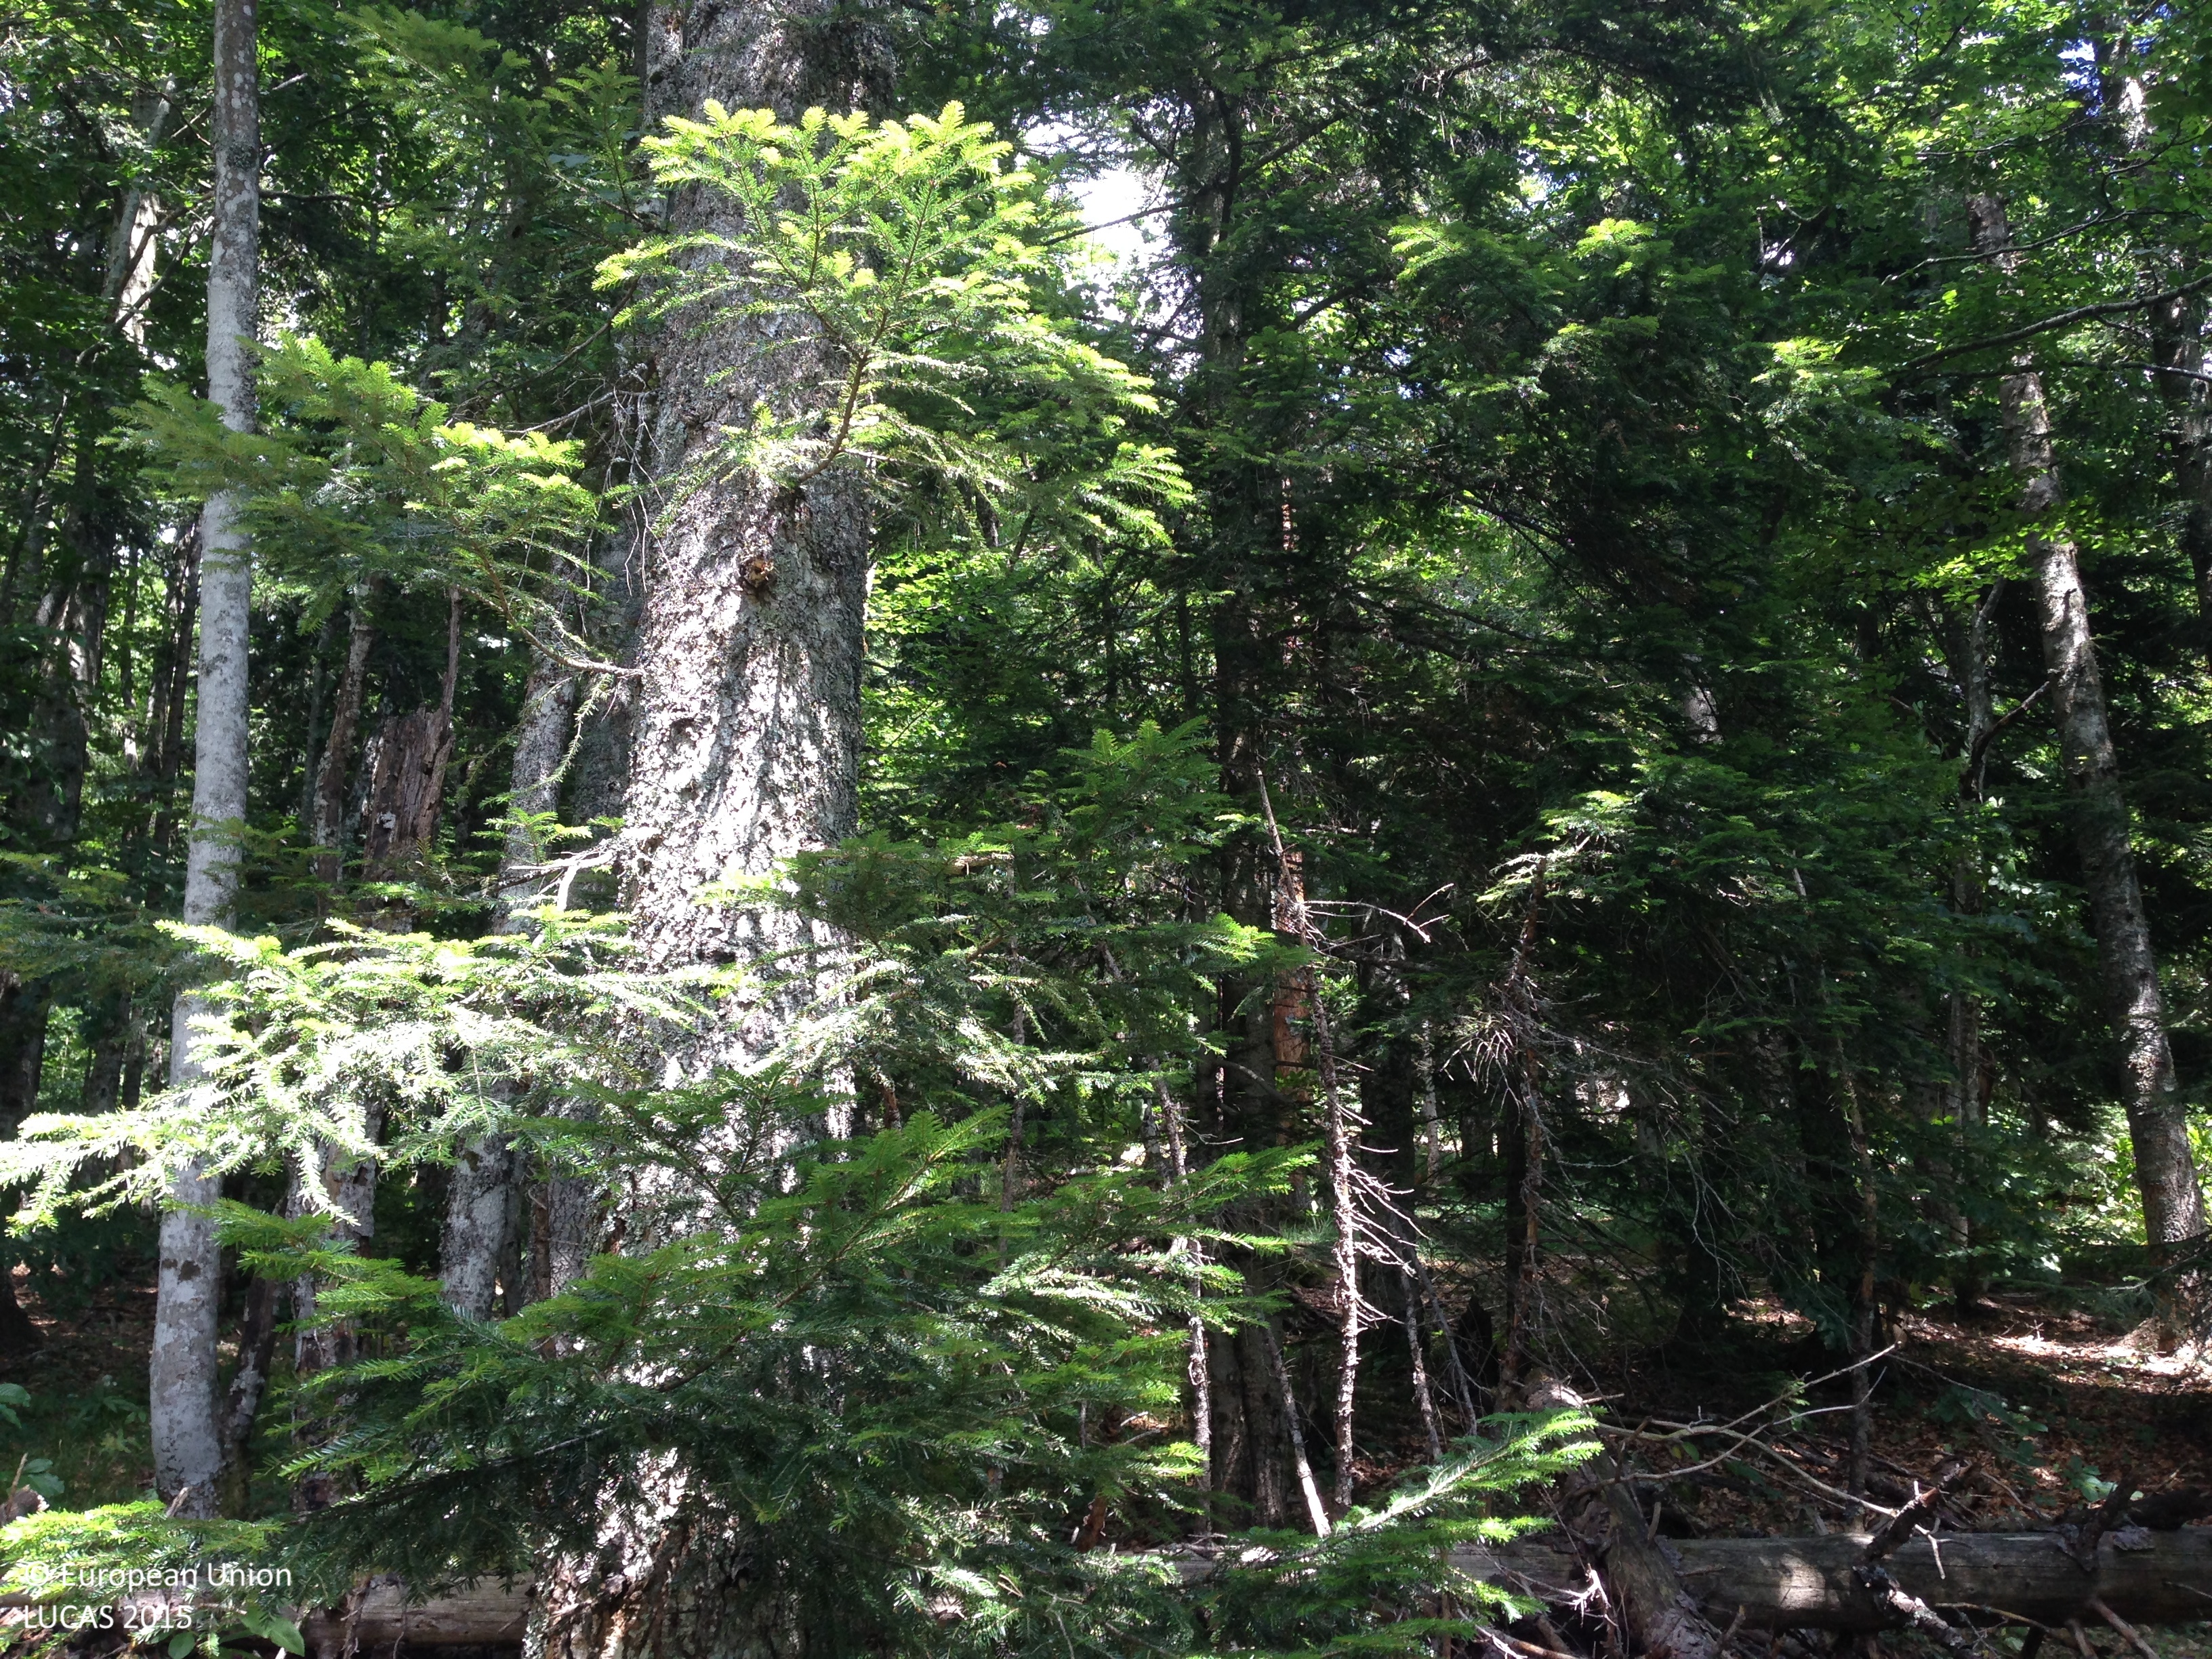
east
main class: Woodland
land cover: Other mixed woodland
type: mountainous beech forest
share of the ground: > 75 %
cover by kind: coniferous forest trees 40 %, broadleaved forest trees 30 %, herbaceous plants 20 %, shrubs 5 %, consolidated bare surface 5 %
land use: Forestry
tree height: > 5 m
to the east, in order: Other mixed woodland
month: June
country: HR
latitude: 44.7892
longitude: 15.7202
